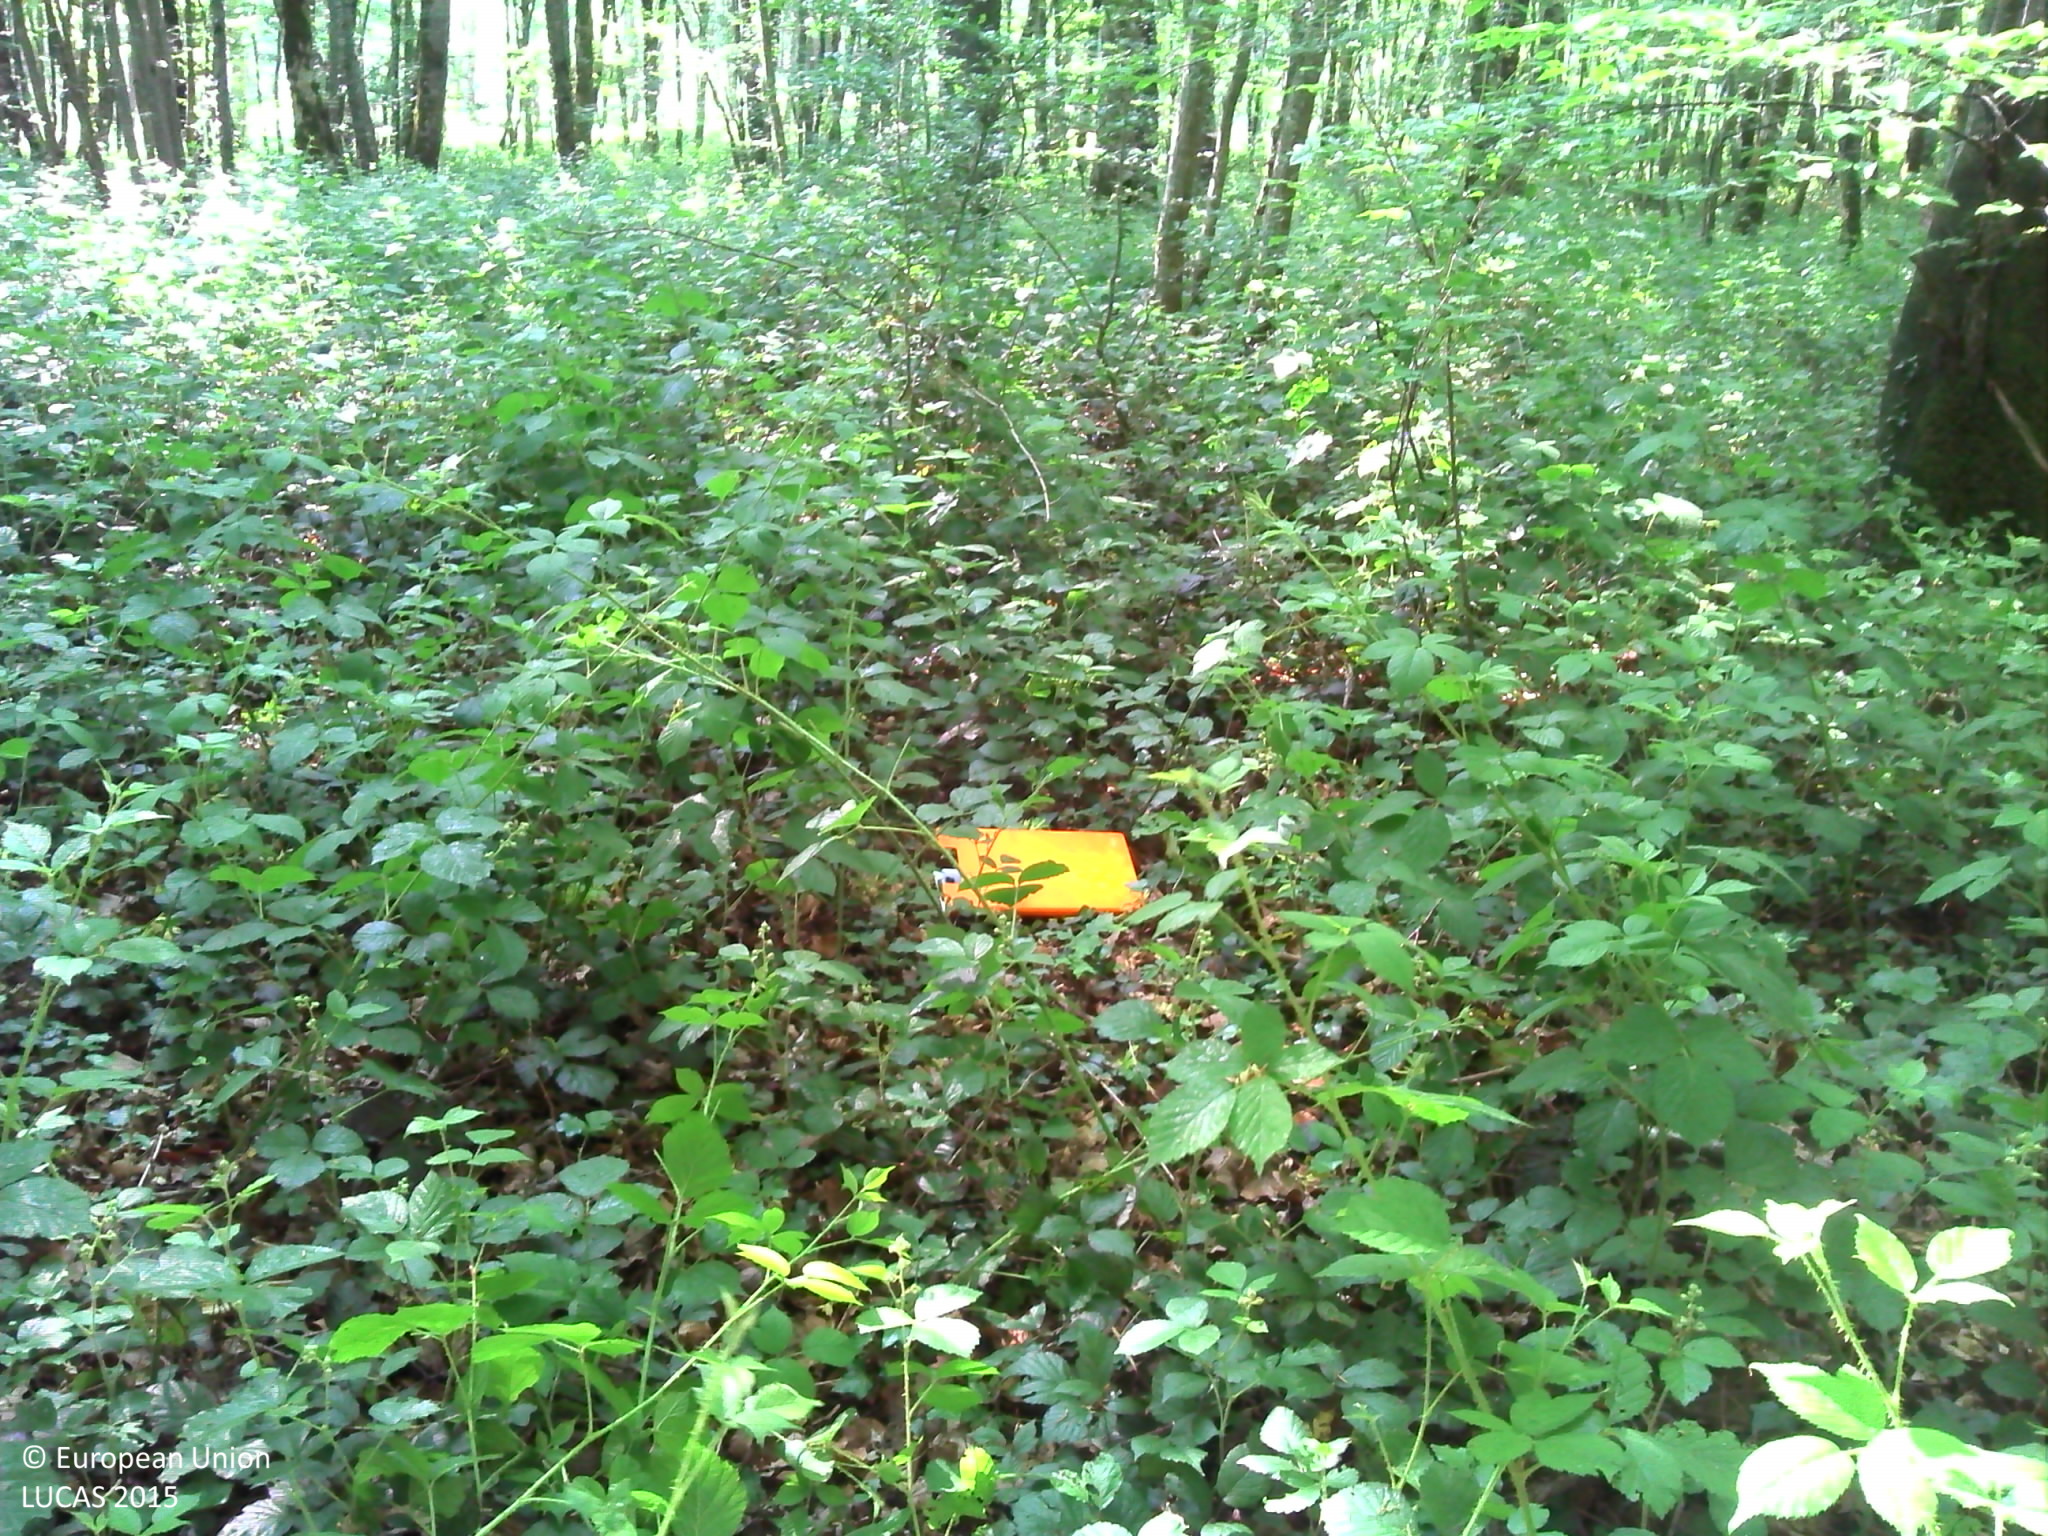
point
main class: Woodland
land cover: Broadleaved woodland
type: beech forest
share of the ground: > 75 %
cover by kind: broadleaved forest trees 95 %, herbaceous plants 5 %
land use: Forestry
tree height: > 5 m
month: June
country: FR
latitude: 47.6188
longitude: 6.2359
